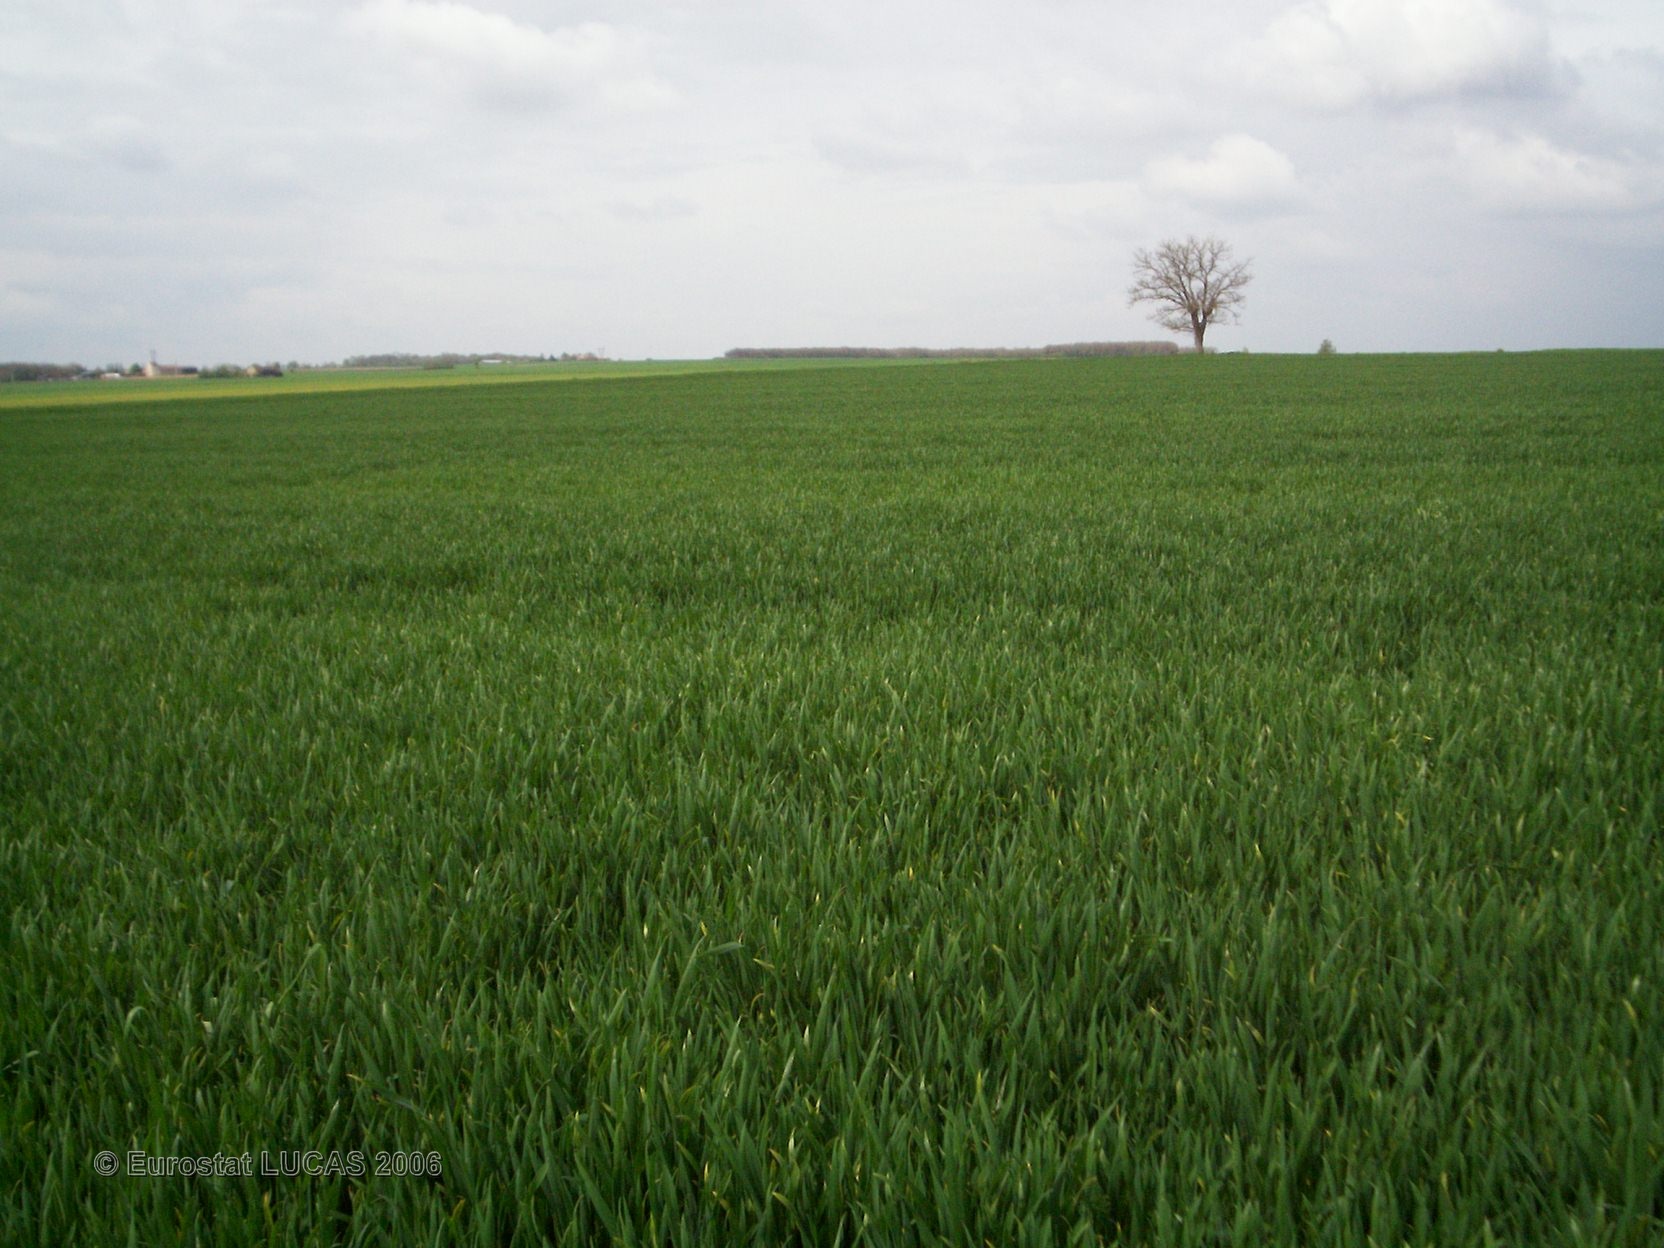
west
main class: Cropland
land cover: Common wheat
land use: Agriculture (excluding fallow land and kitchen gardens)
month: April
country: FR
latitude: 47.0163
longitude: 0.3098
